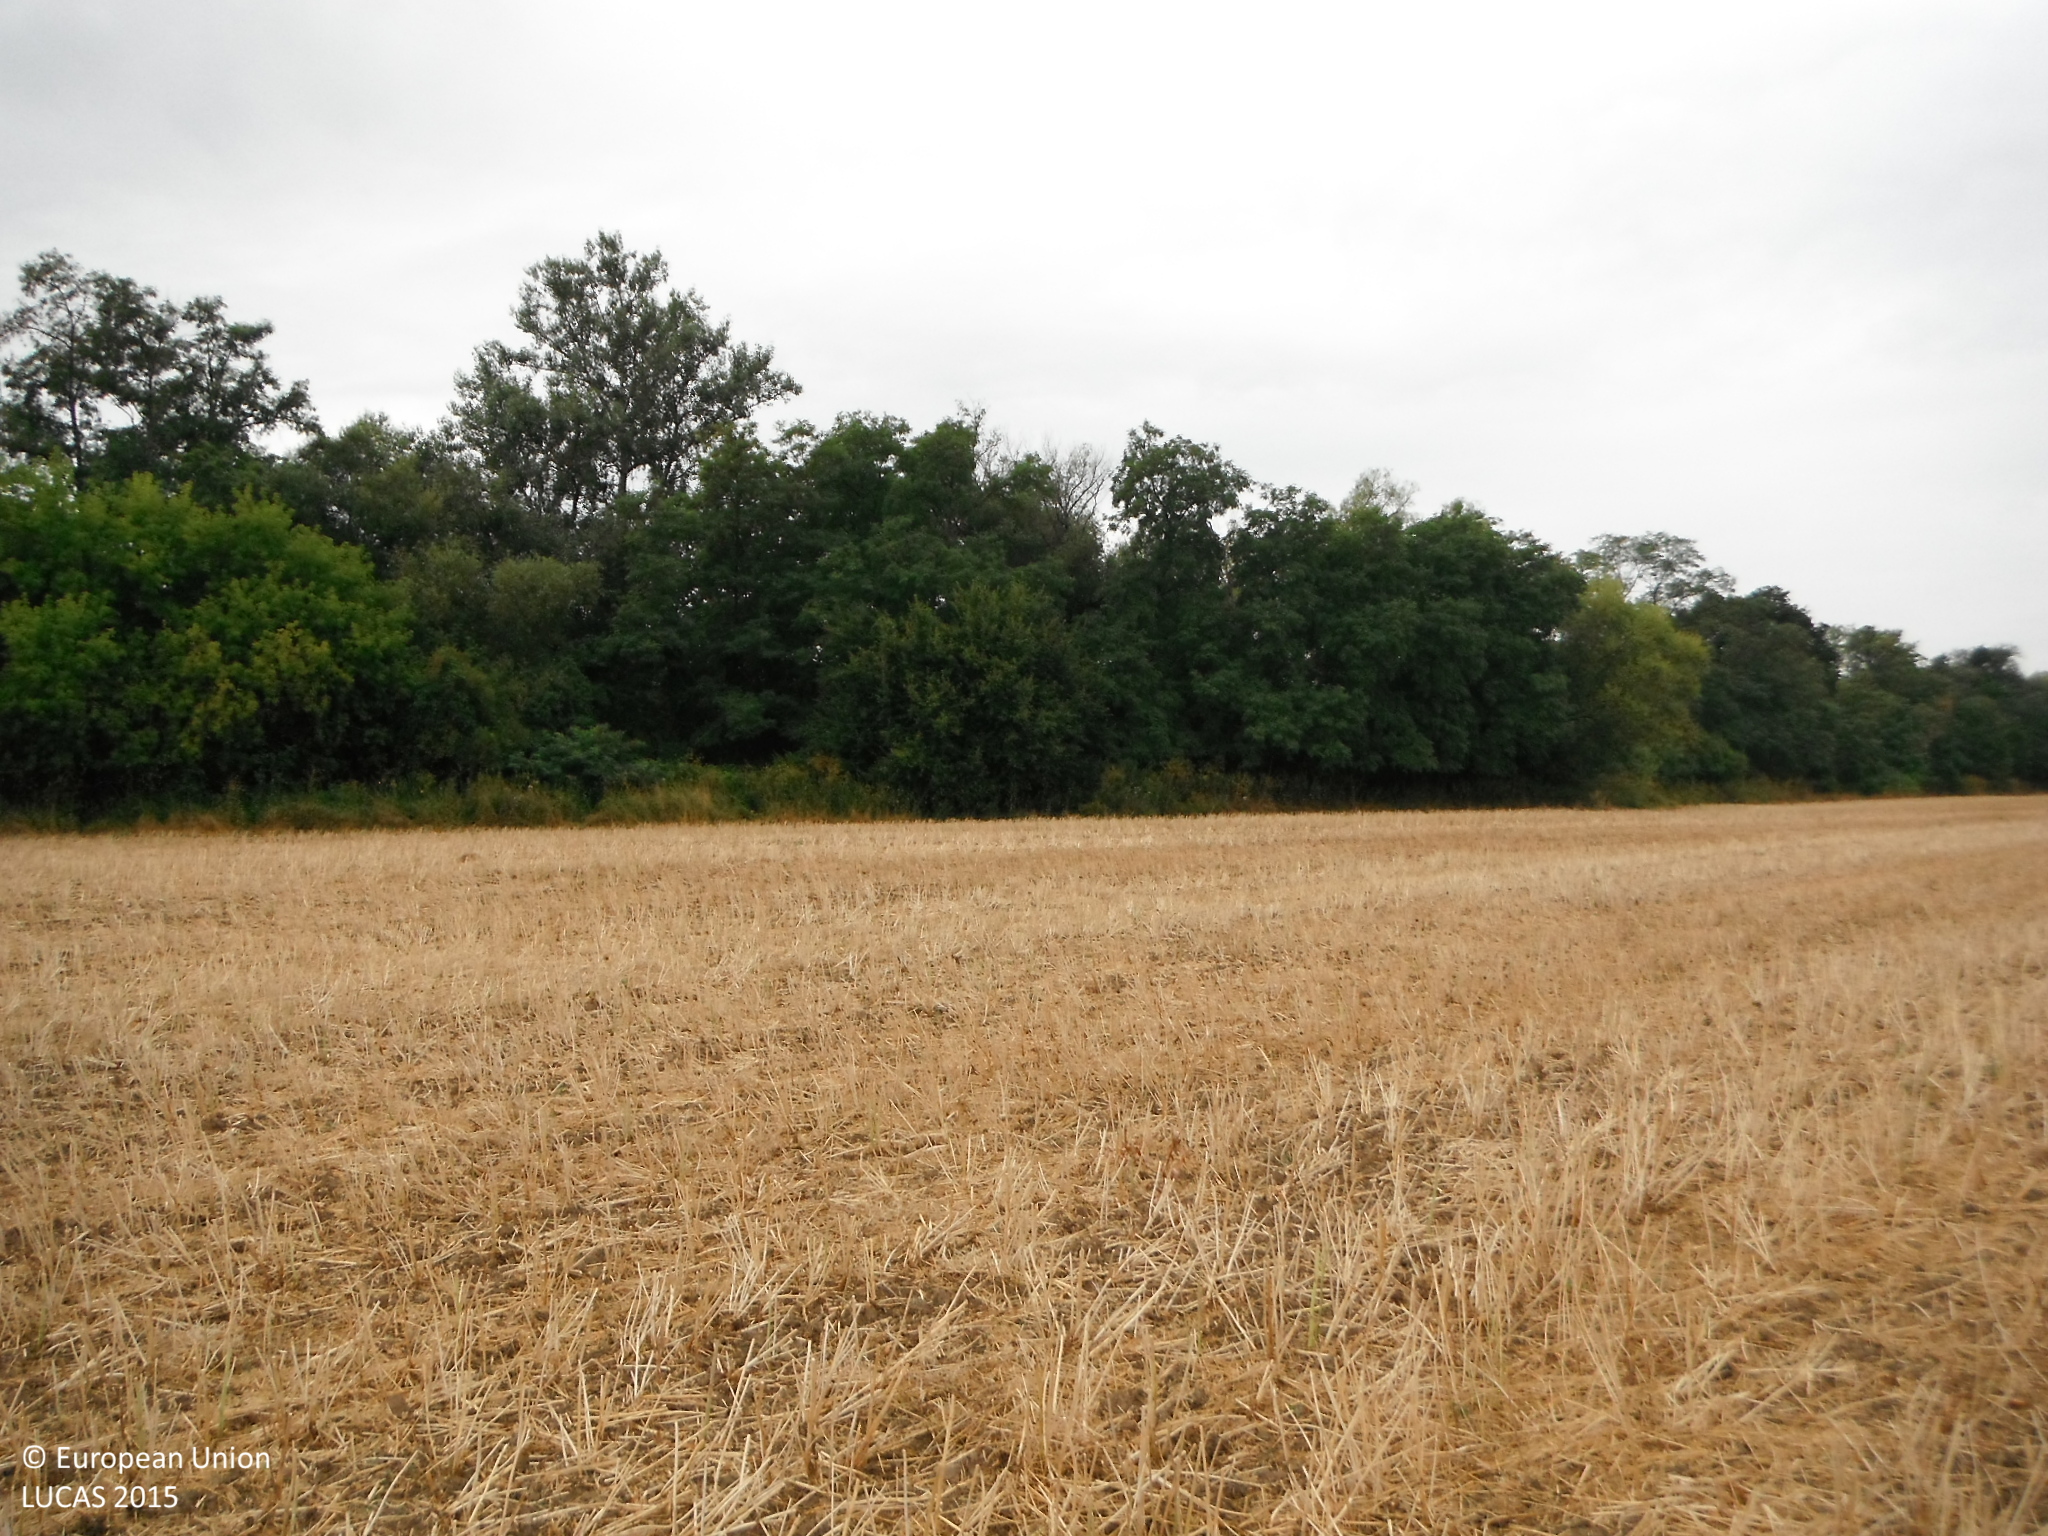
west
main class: Cropland
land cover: Rape and turnip rape
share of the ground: 25 - 50 %
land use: Agriculture (excluding fallow land and kitchen gardens)
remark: Harvested field
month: July
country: SK
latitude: 48.6610
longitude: 18.1746
